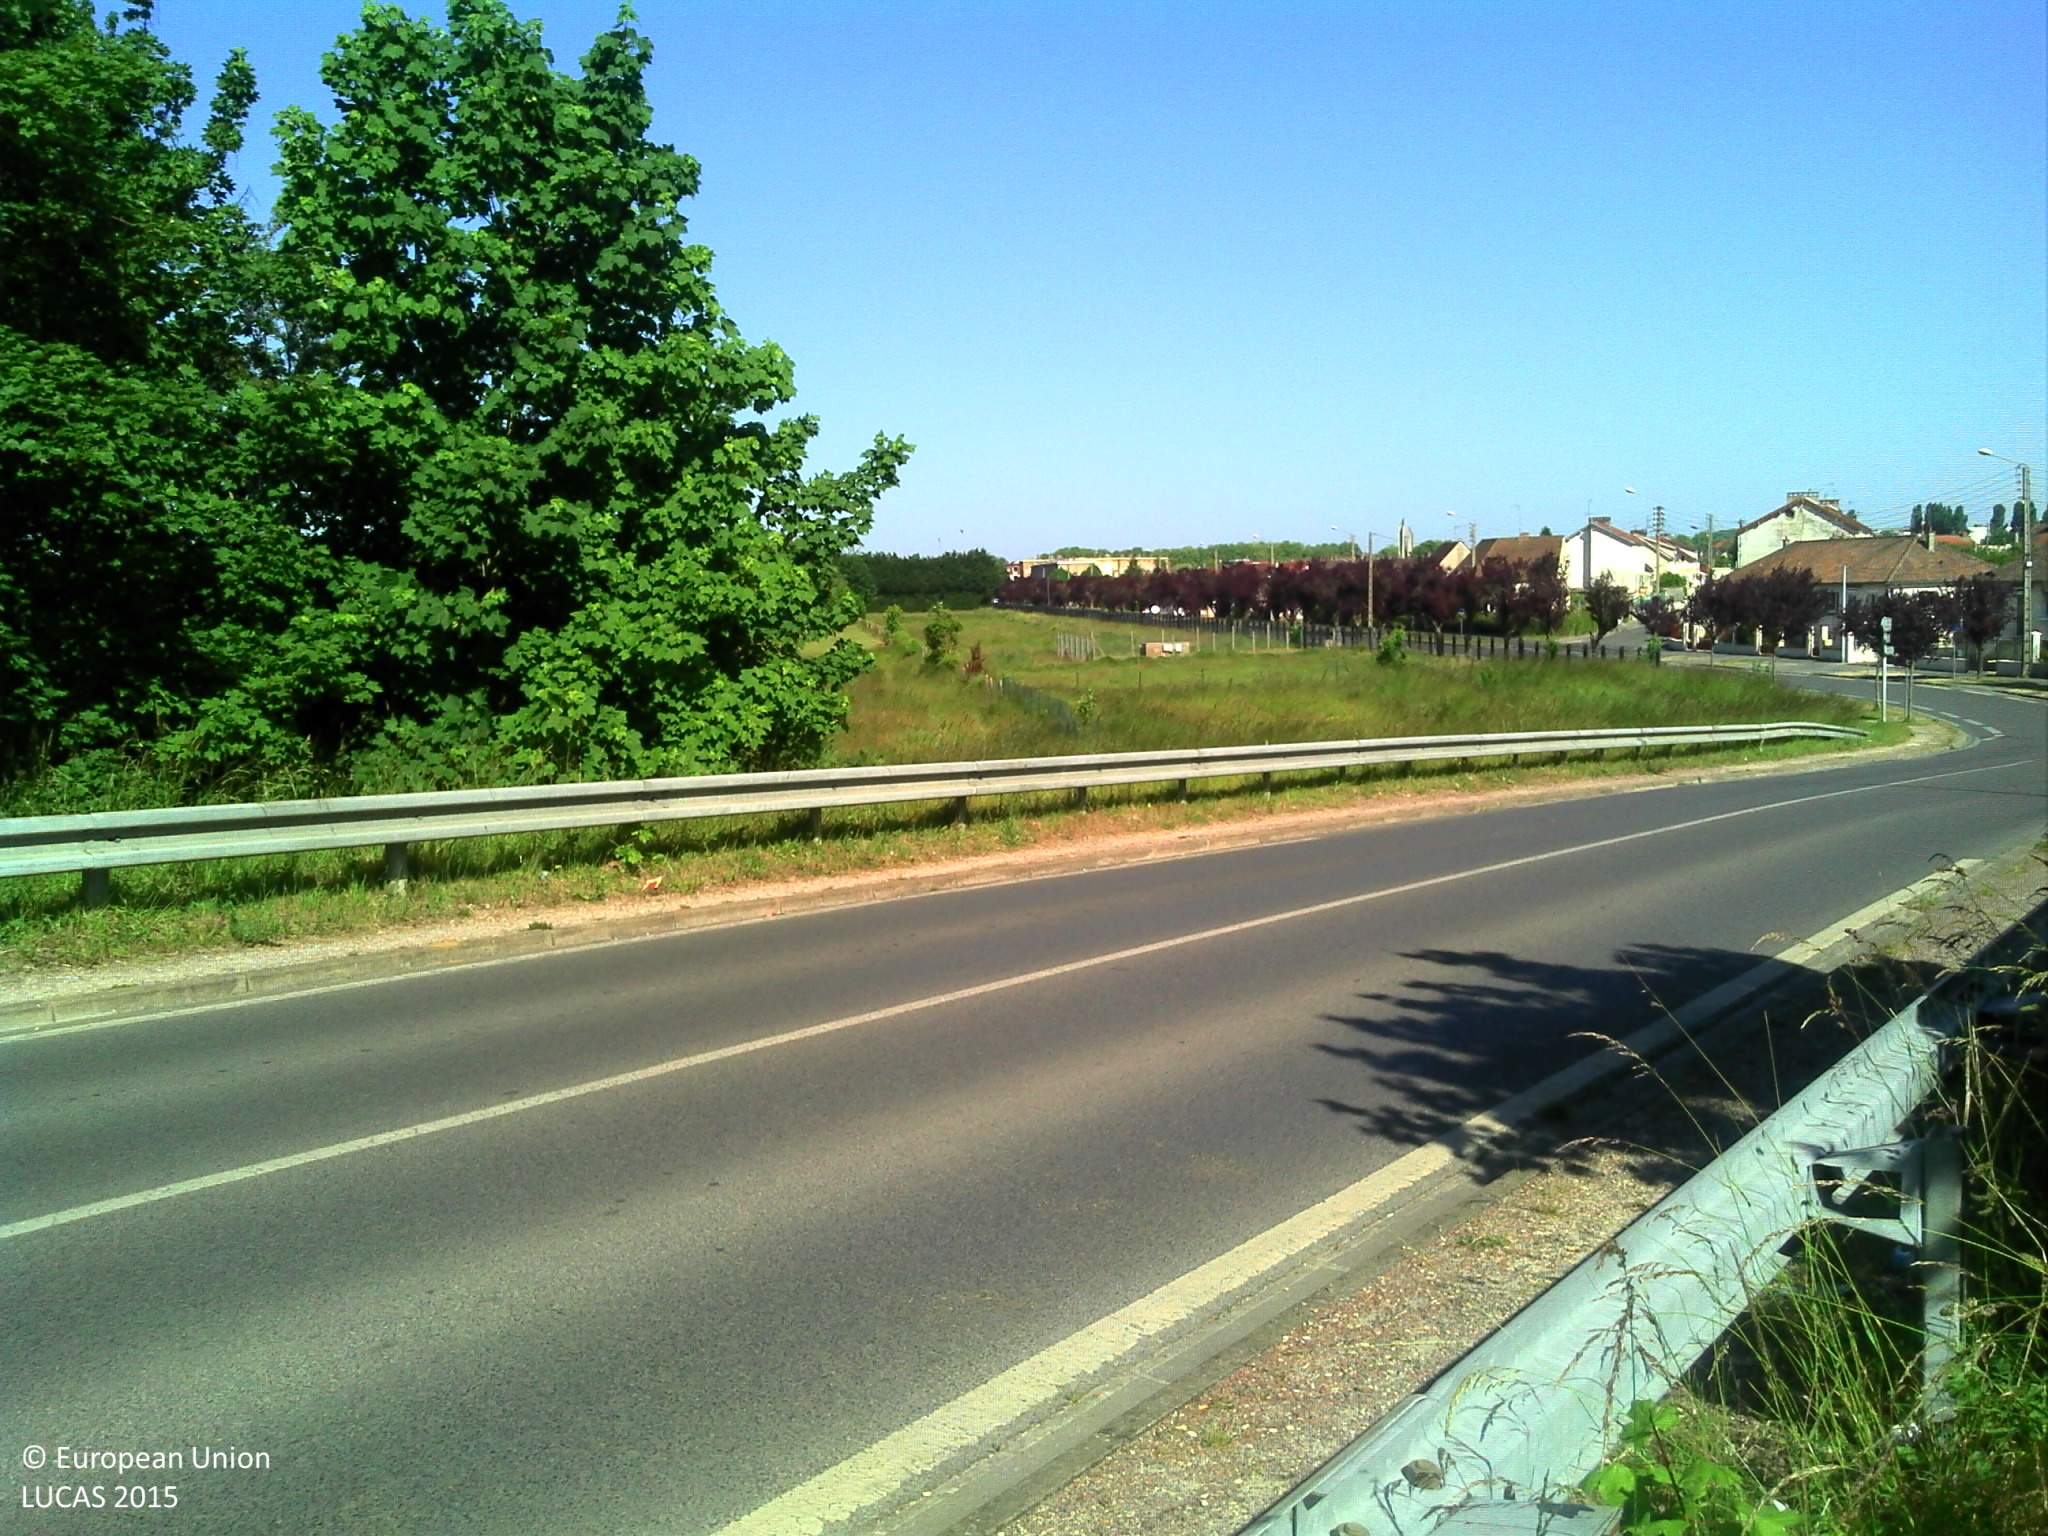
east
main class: Grassland
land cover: Spontaneously vegetated surfaces
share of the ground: > 75 %
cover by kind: herbaceous plants 95 %, shrubs 5 %
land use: Semi-natural and natural areas not in use
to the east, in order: Spontaneously vegetated surfaces; Paved roads, cycling and walking lanes; Grassland without tree/shrub cover; Tracks; Lines of trees; Grassland with sparse tree/shrub cover
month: June
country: FR
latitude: 49.3922
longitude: 3.3099
